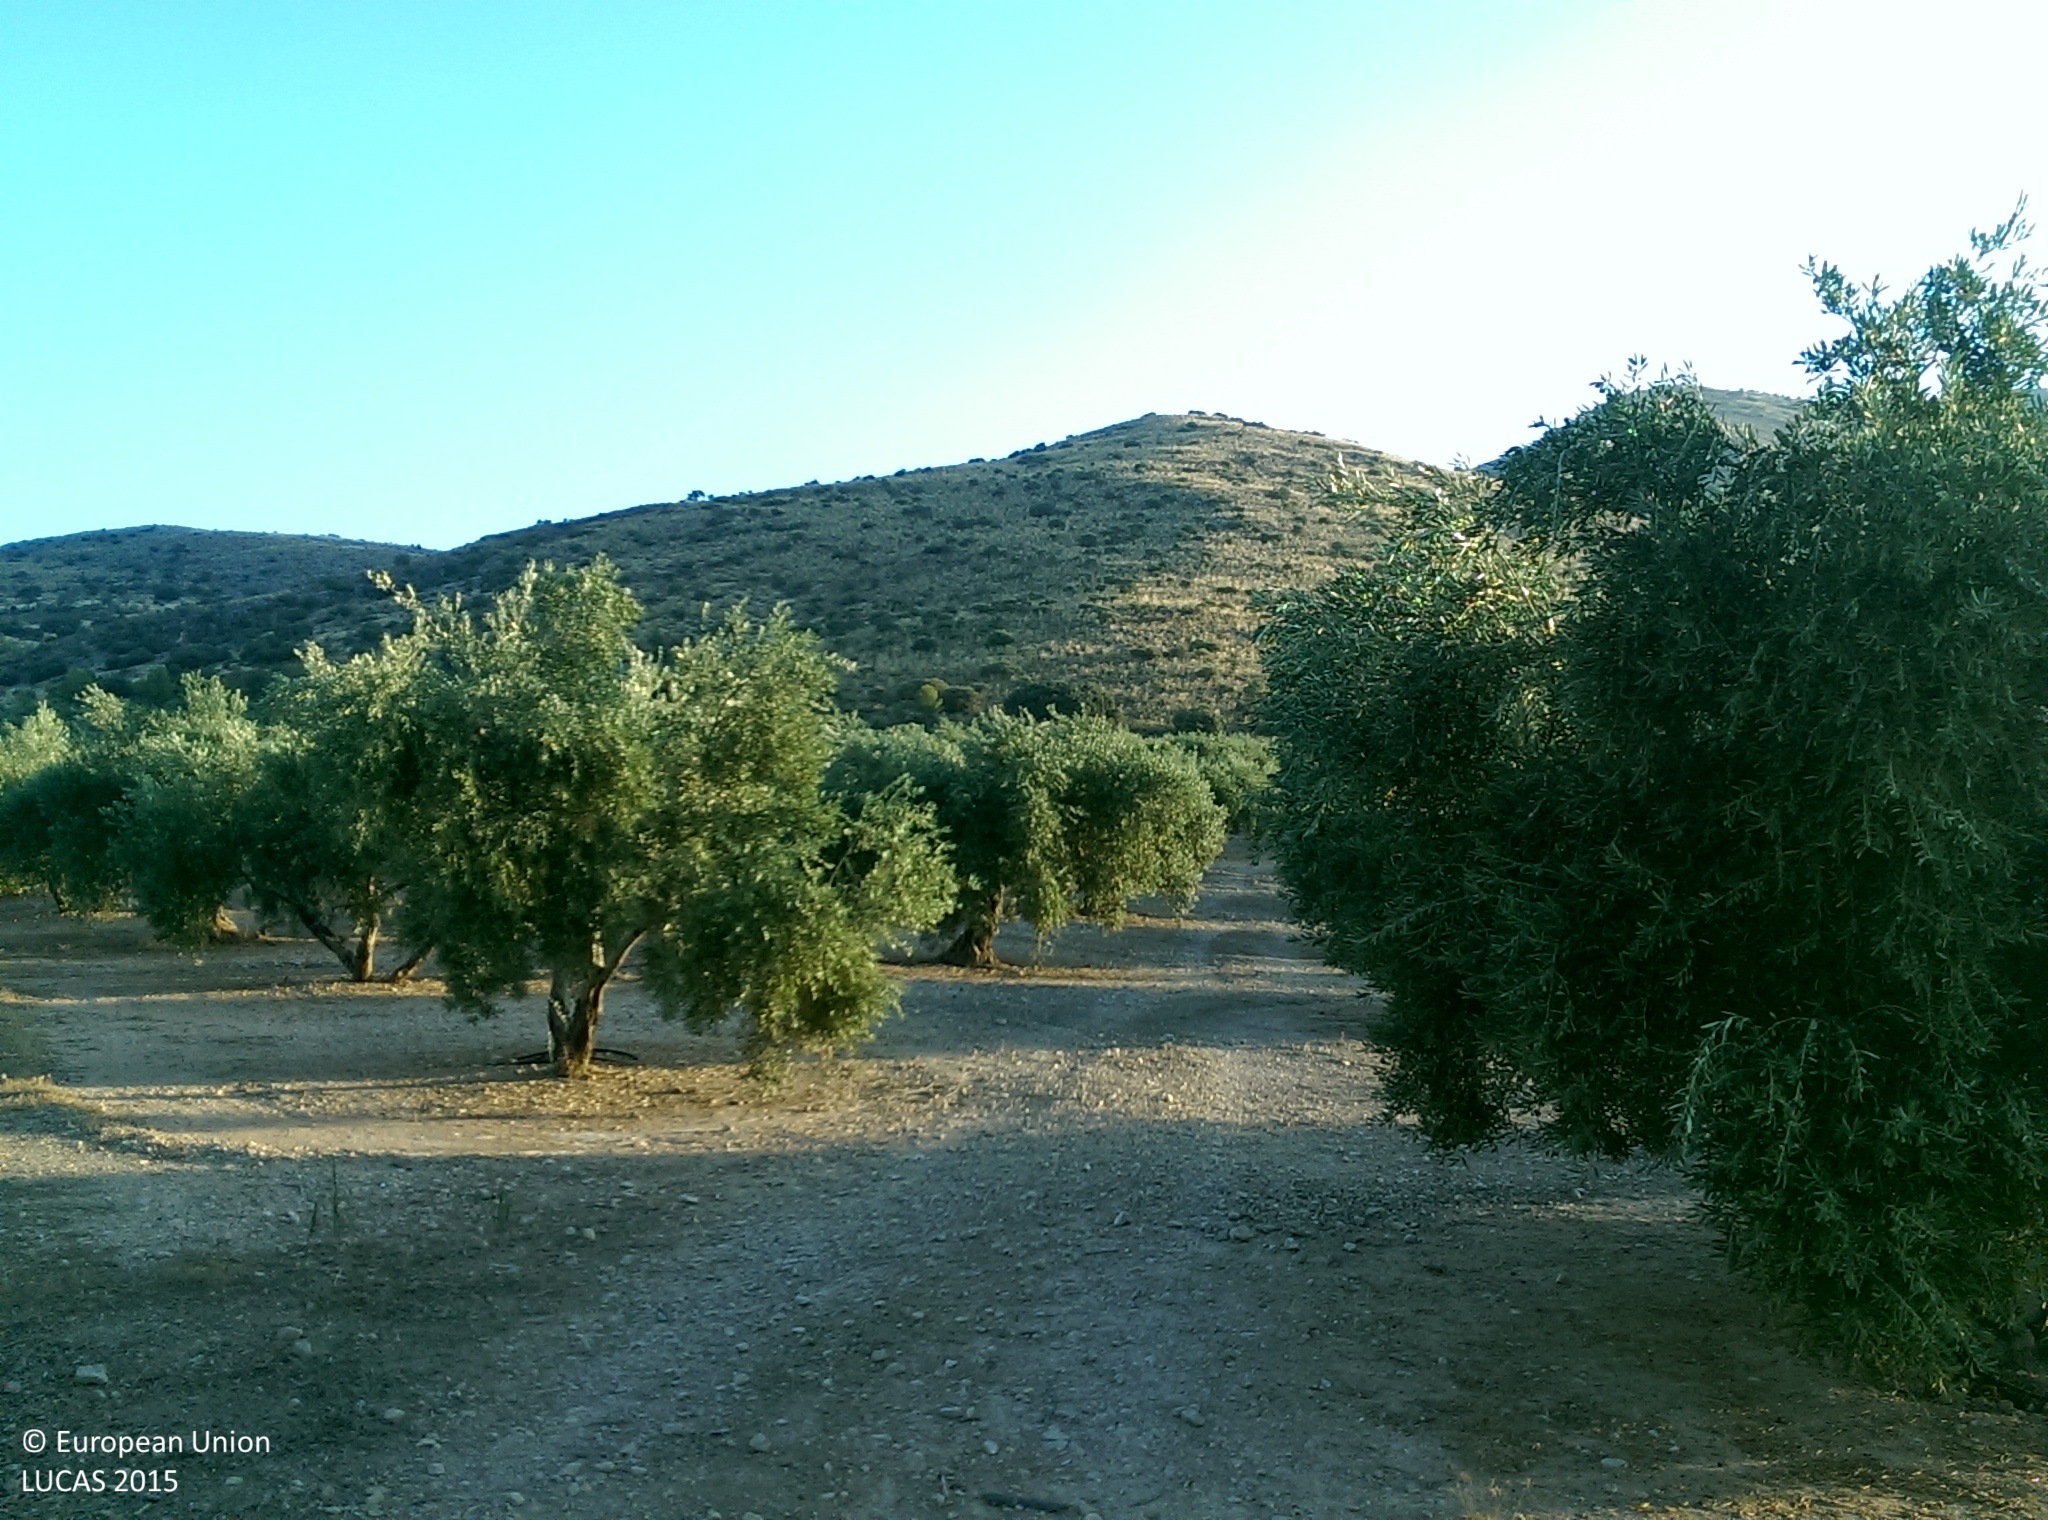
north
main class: Cropland
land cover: Olive groves
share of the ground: 50 - 75 %
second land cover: Other bare soil
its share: > 75 %
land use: Agriculture (excluding fallow land and kitchen gardens)
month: July
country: ES
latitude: 37.3408
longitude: -3.6846
